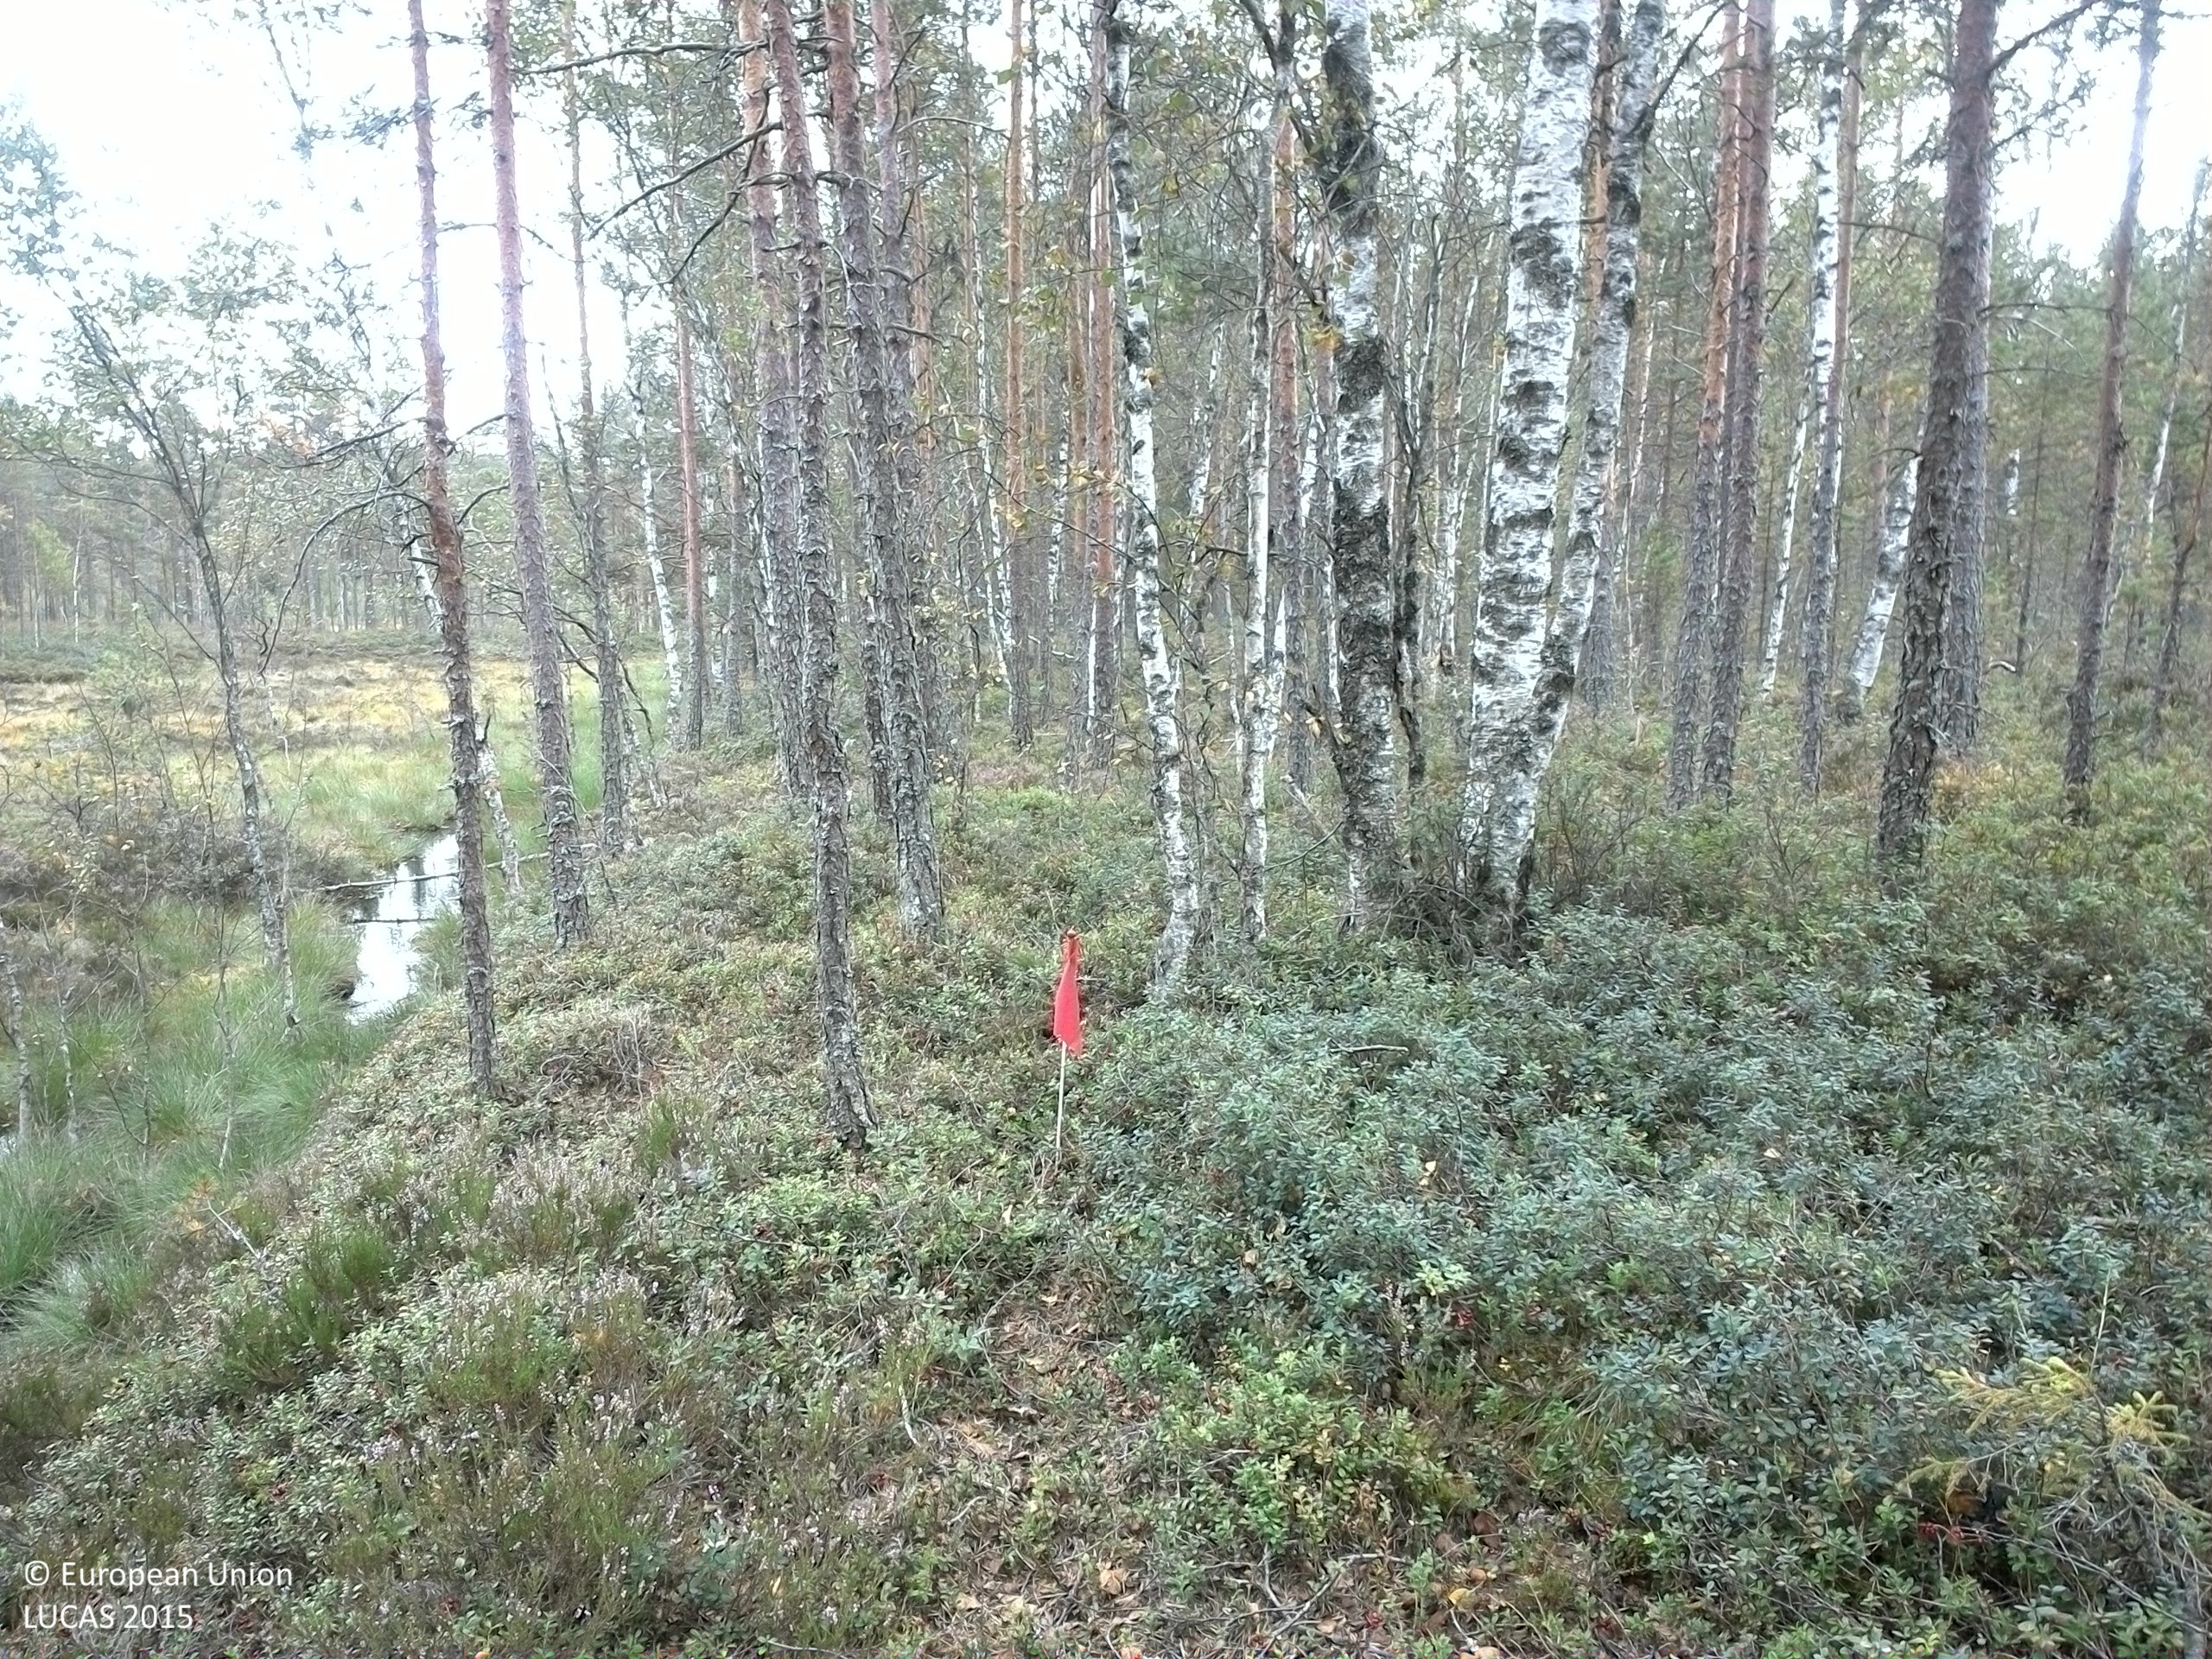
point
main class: Woodland
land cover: Pine dominated mixed woodland
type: boreal forest
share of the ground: 50 - 75 %
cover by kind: coniferous forest trees 40 %, broadleaved forest trees 25 %, shrubs 25 %, lichens and mosses 10 %
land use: Forestry
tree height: > 5 m
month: September
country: SE
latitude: 59.7983
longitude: 13.3598
